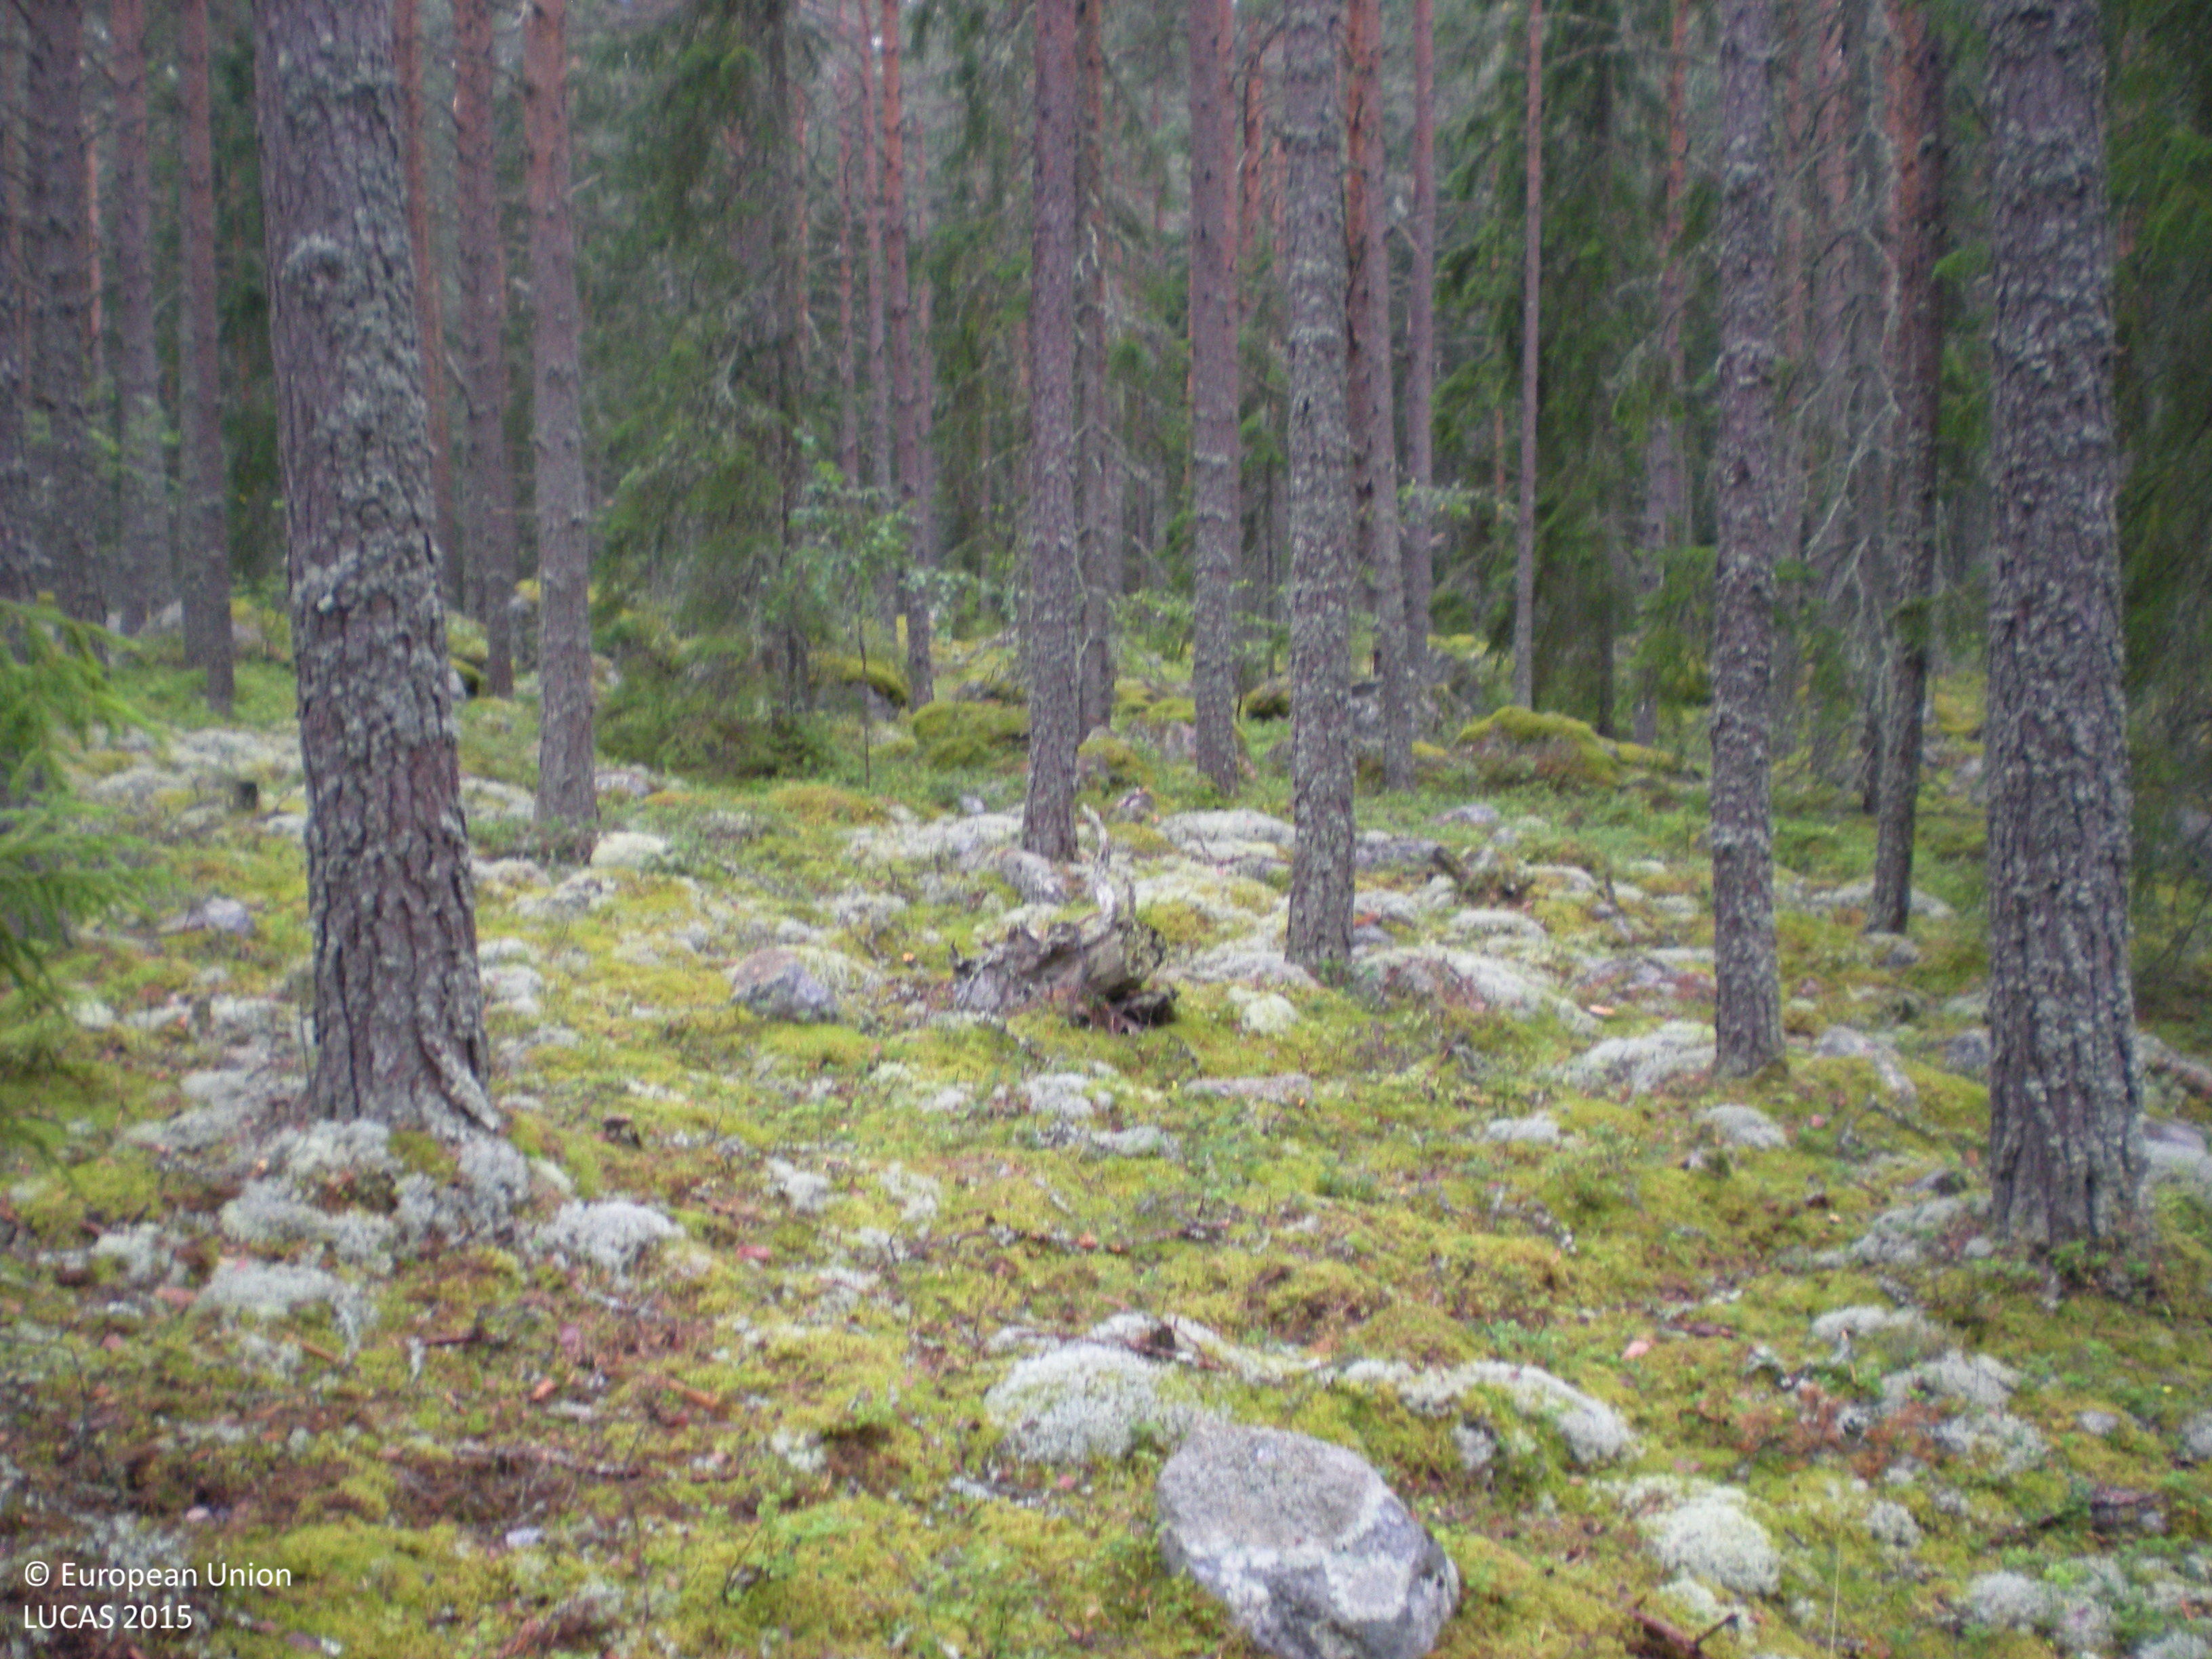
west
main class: Woodland
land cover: Pine dominated coniferous woodland
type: boreal forest
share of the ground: 50 - 75 %
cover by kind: coniferous forest trees 65 %, shrubs 20 %, lichens and mosses 10 %, consolidated bare surface 5 %
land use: Forestry
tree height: > 5 m
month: August
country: SE
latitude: 60.7706
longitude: 17.2773
